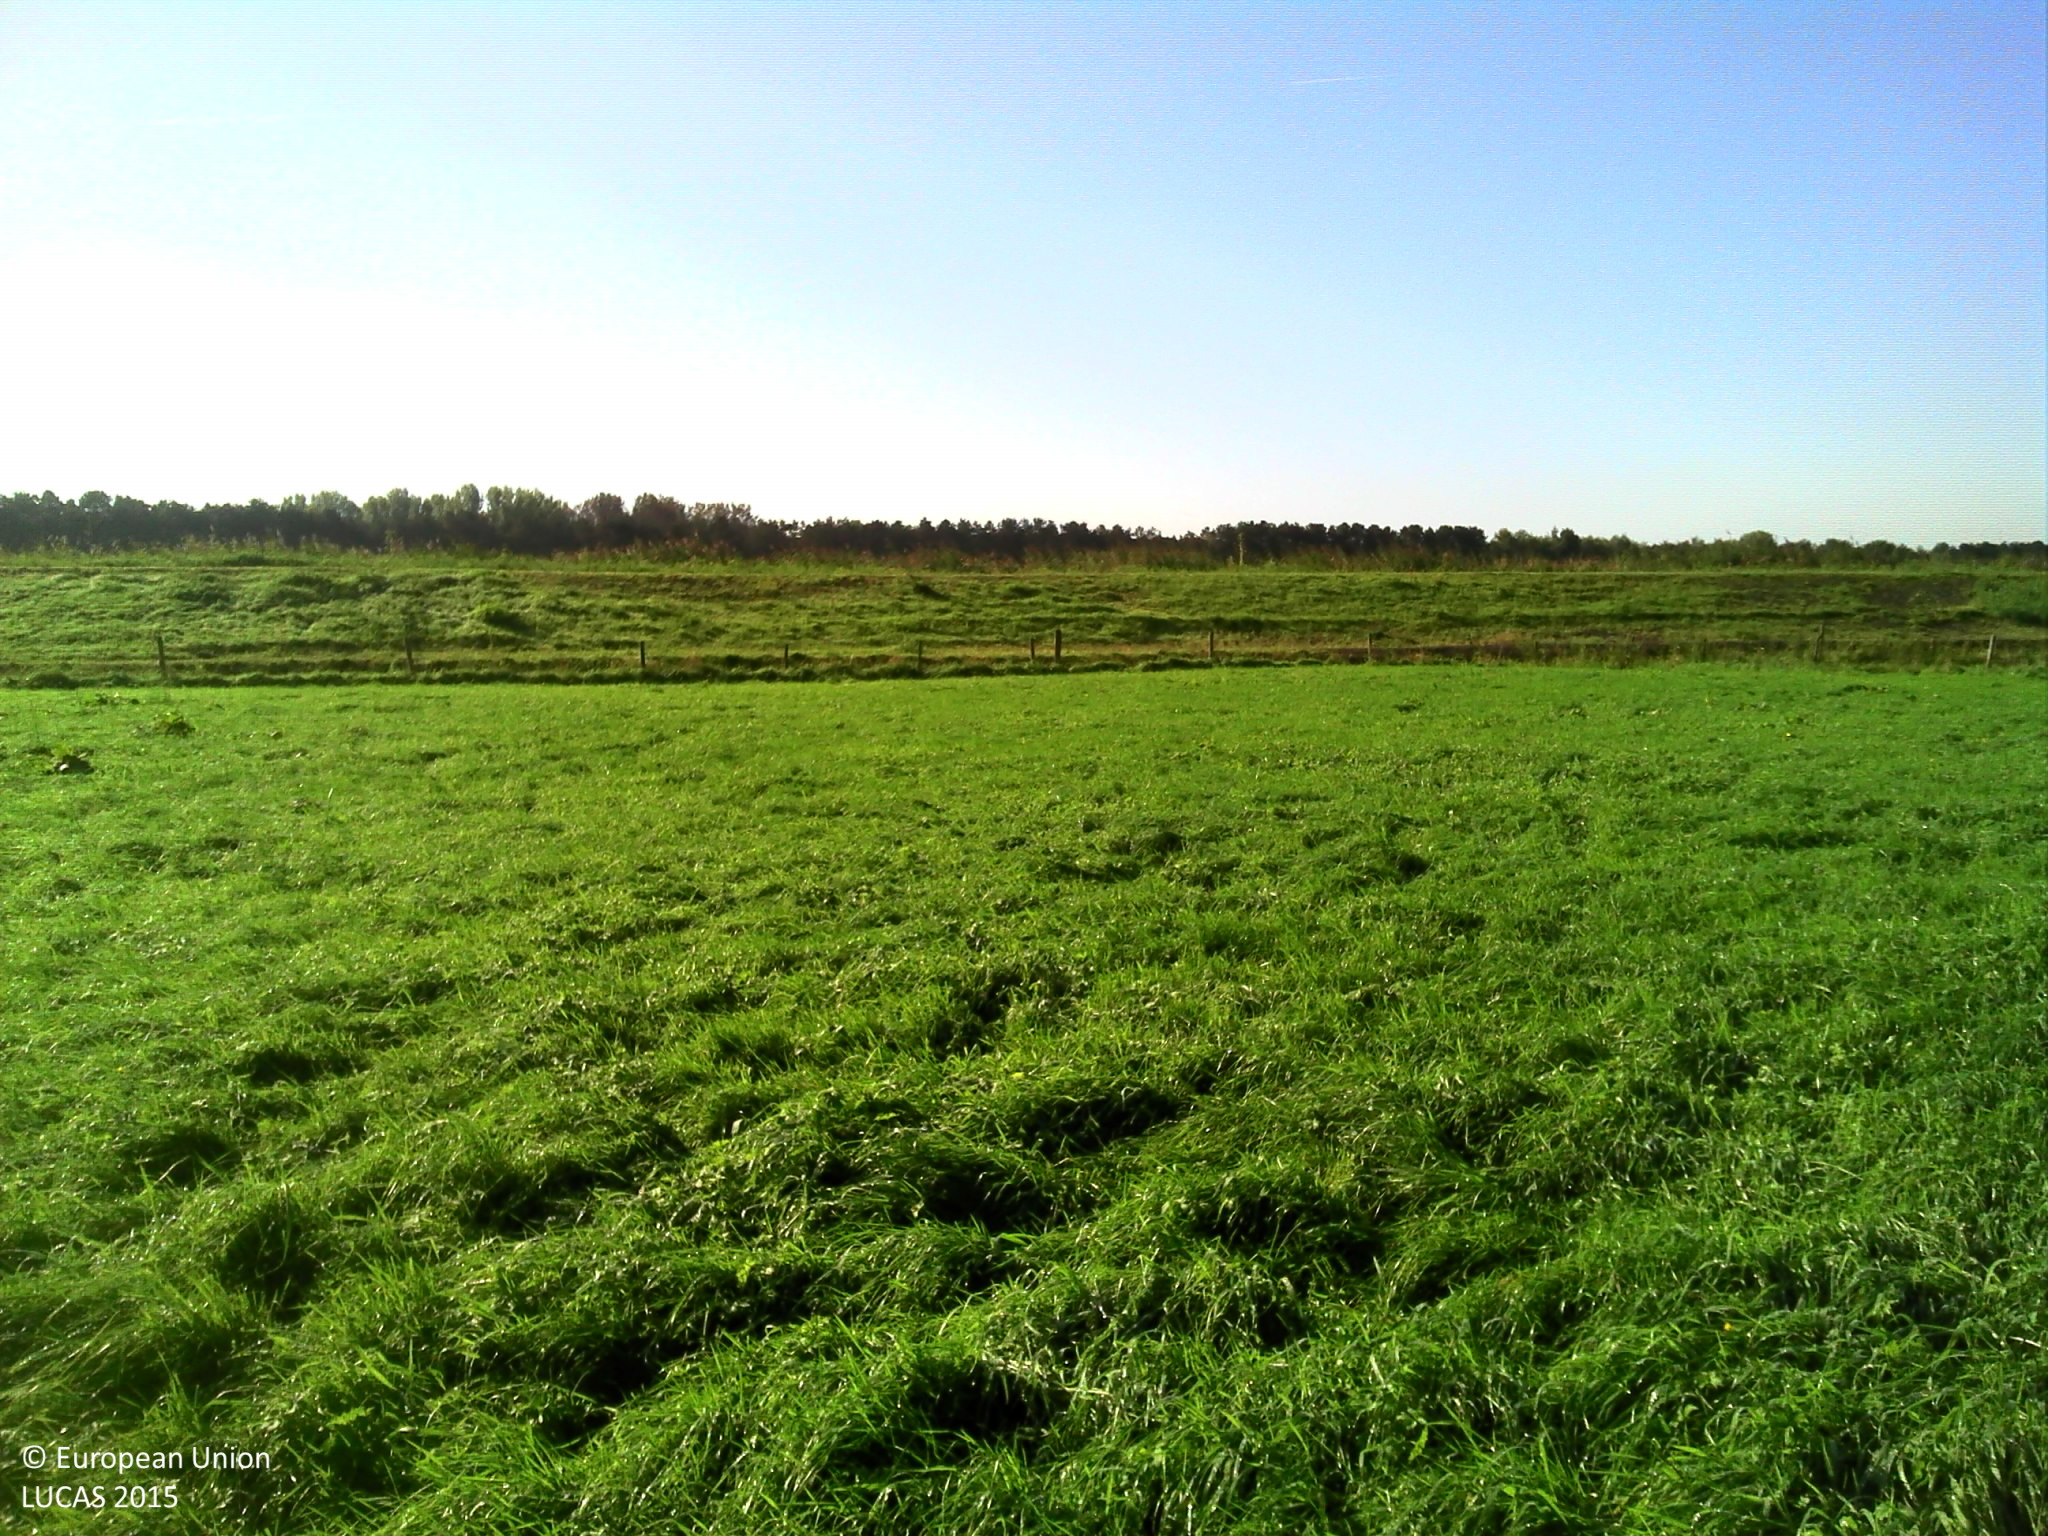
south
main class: Grassland
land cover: Grassland without tree/shrub cover
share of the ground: > 75 %
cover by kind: herbaceous plants 100 %
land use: Agriculture (excluding fallow land and kitchen gardens)
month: September
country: BE
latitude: 51.1174
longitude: 4.5530
